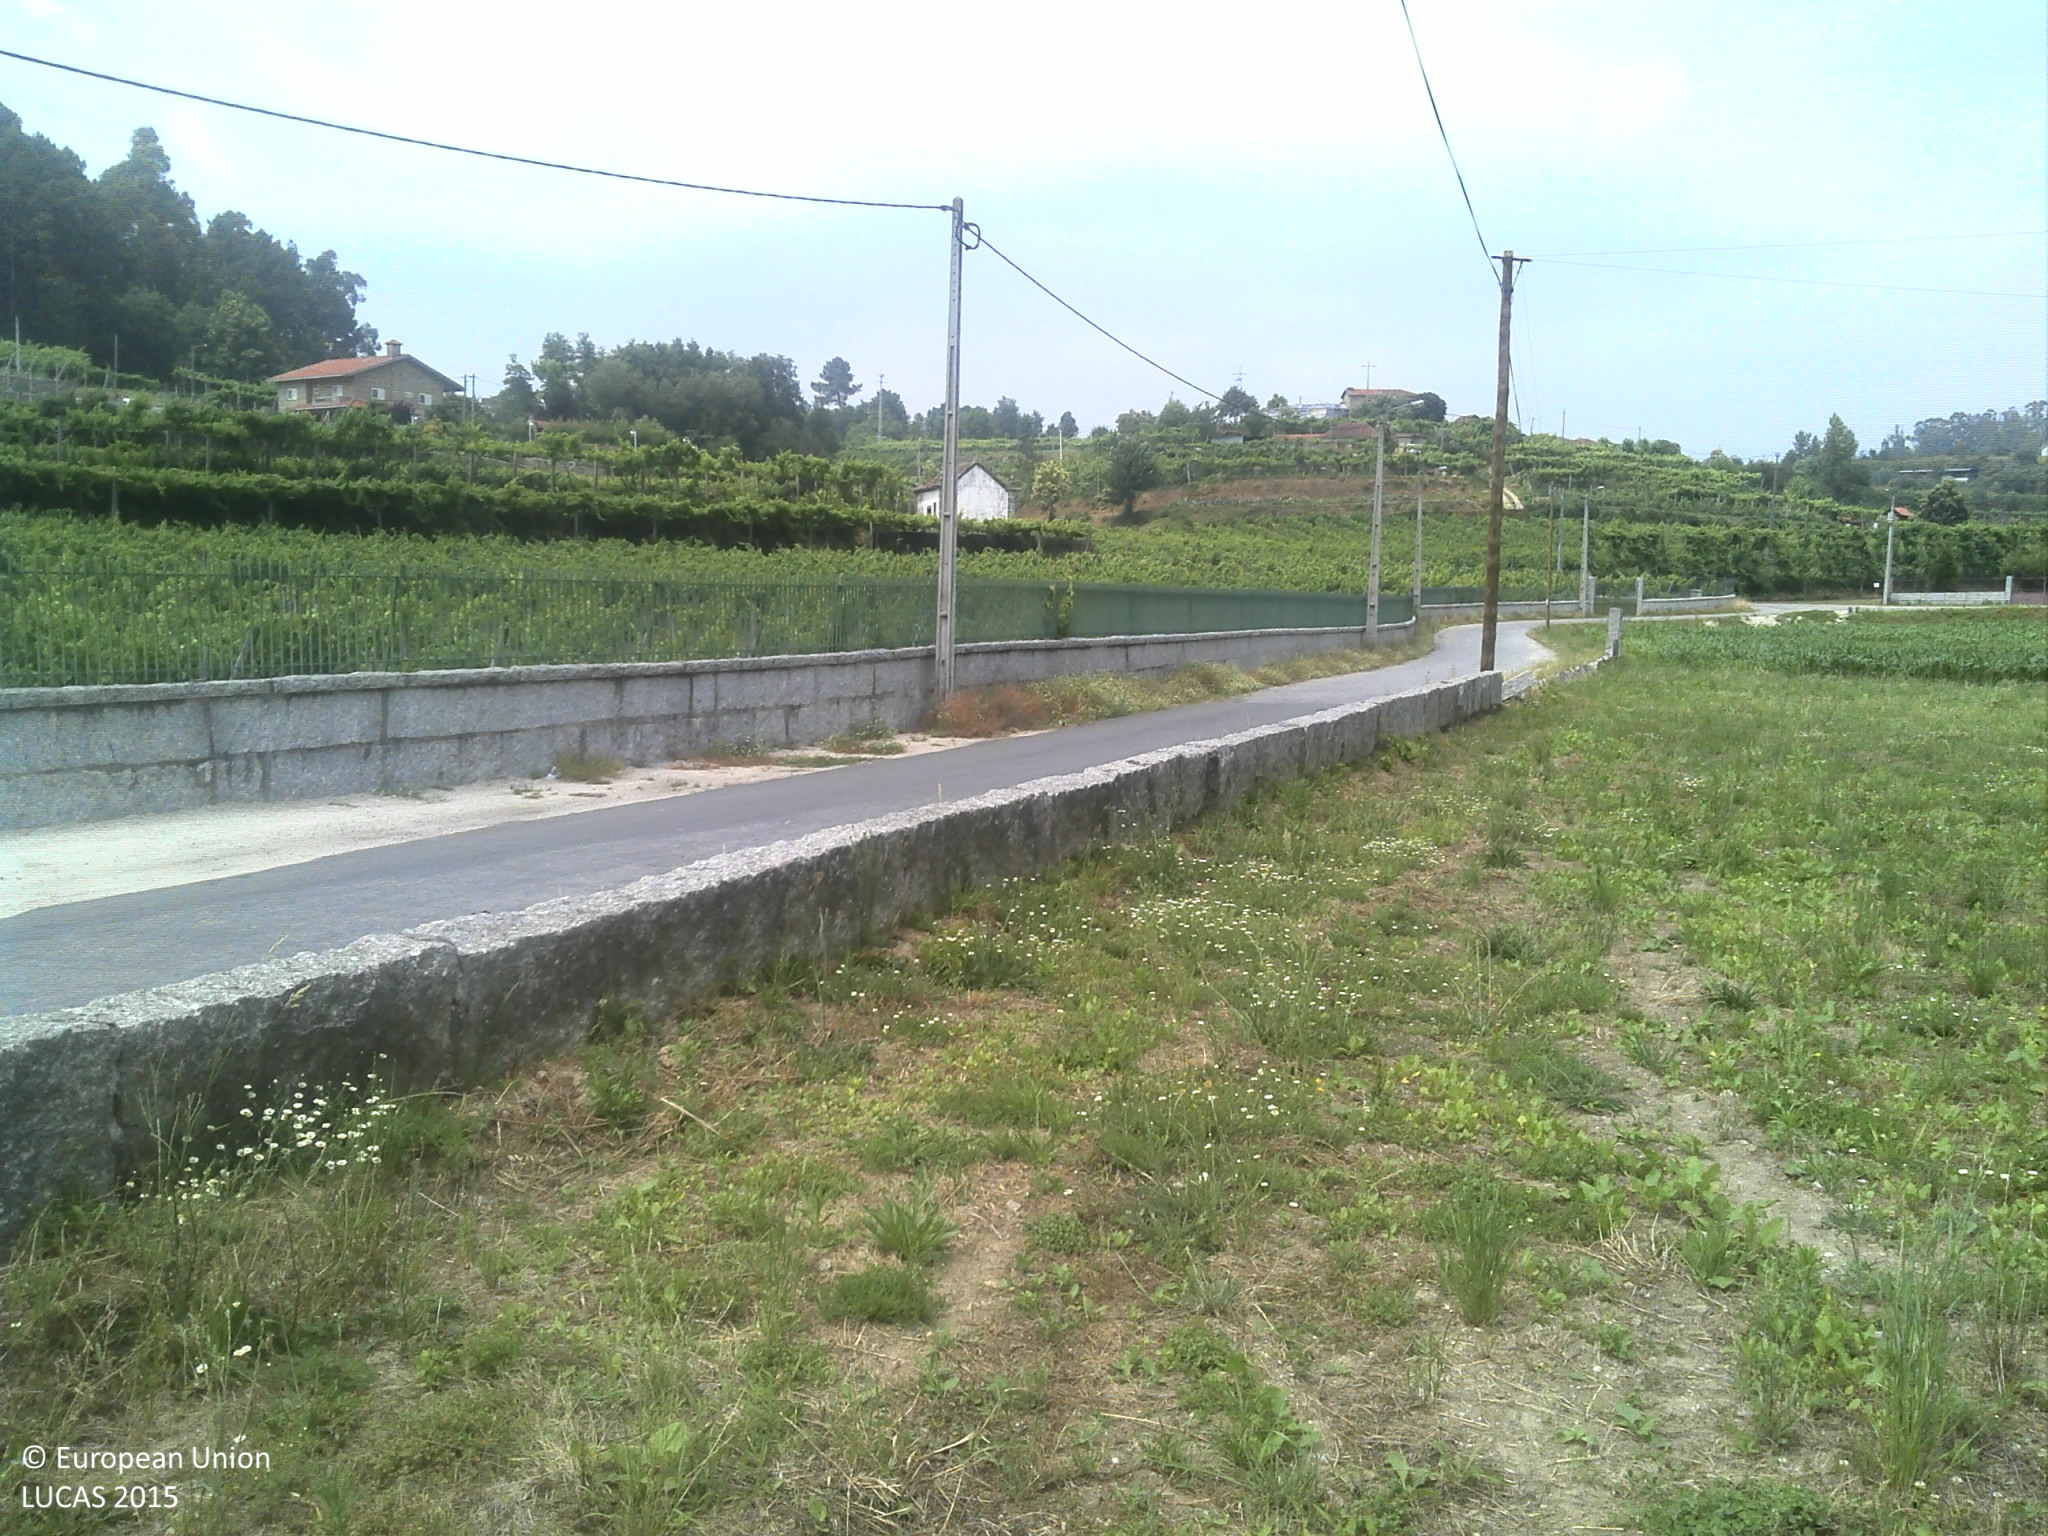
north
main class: Grassland
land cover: Spontaneously vegetated surfaces
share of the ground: 50 - 75 %
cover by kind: herbaceous plants 65 %, unconsolidated bare surface 35 %
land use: Fallow land
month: June
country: PT
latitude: 41.3262
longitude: -8.1717
